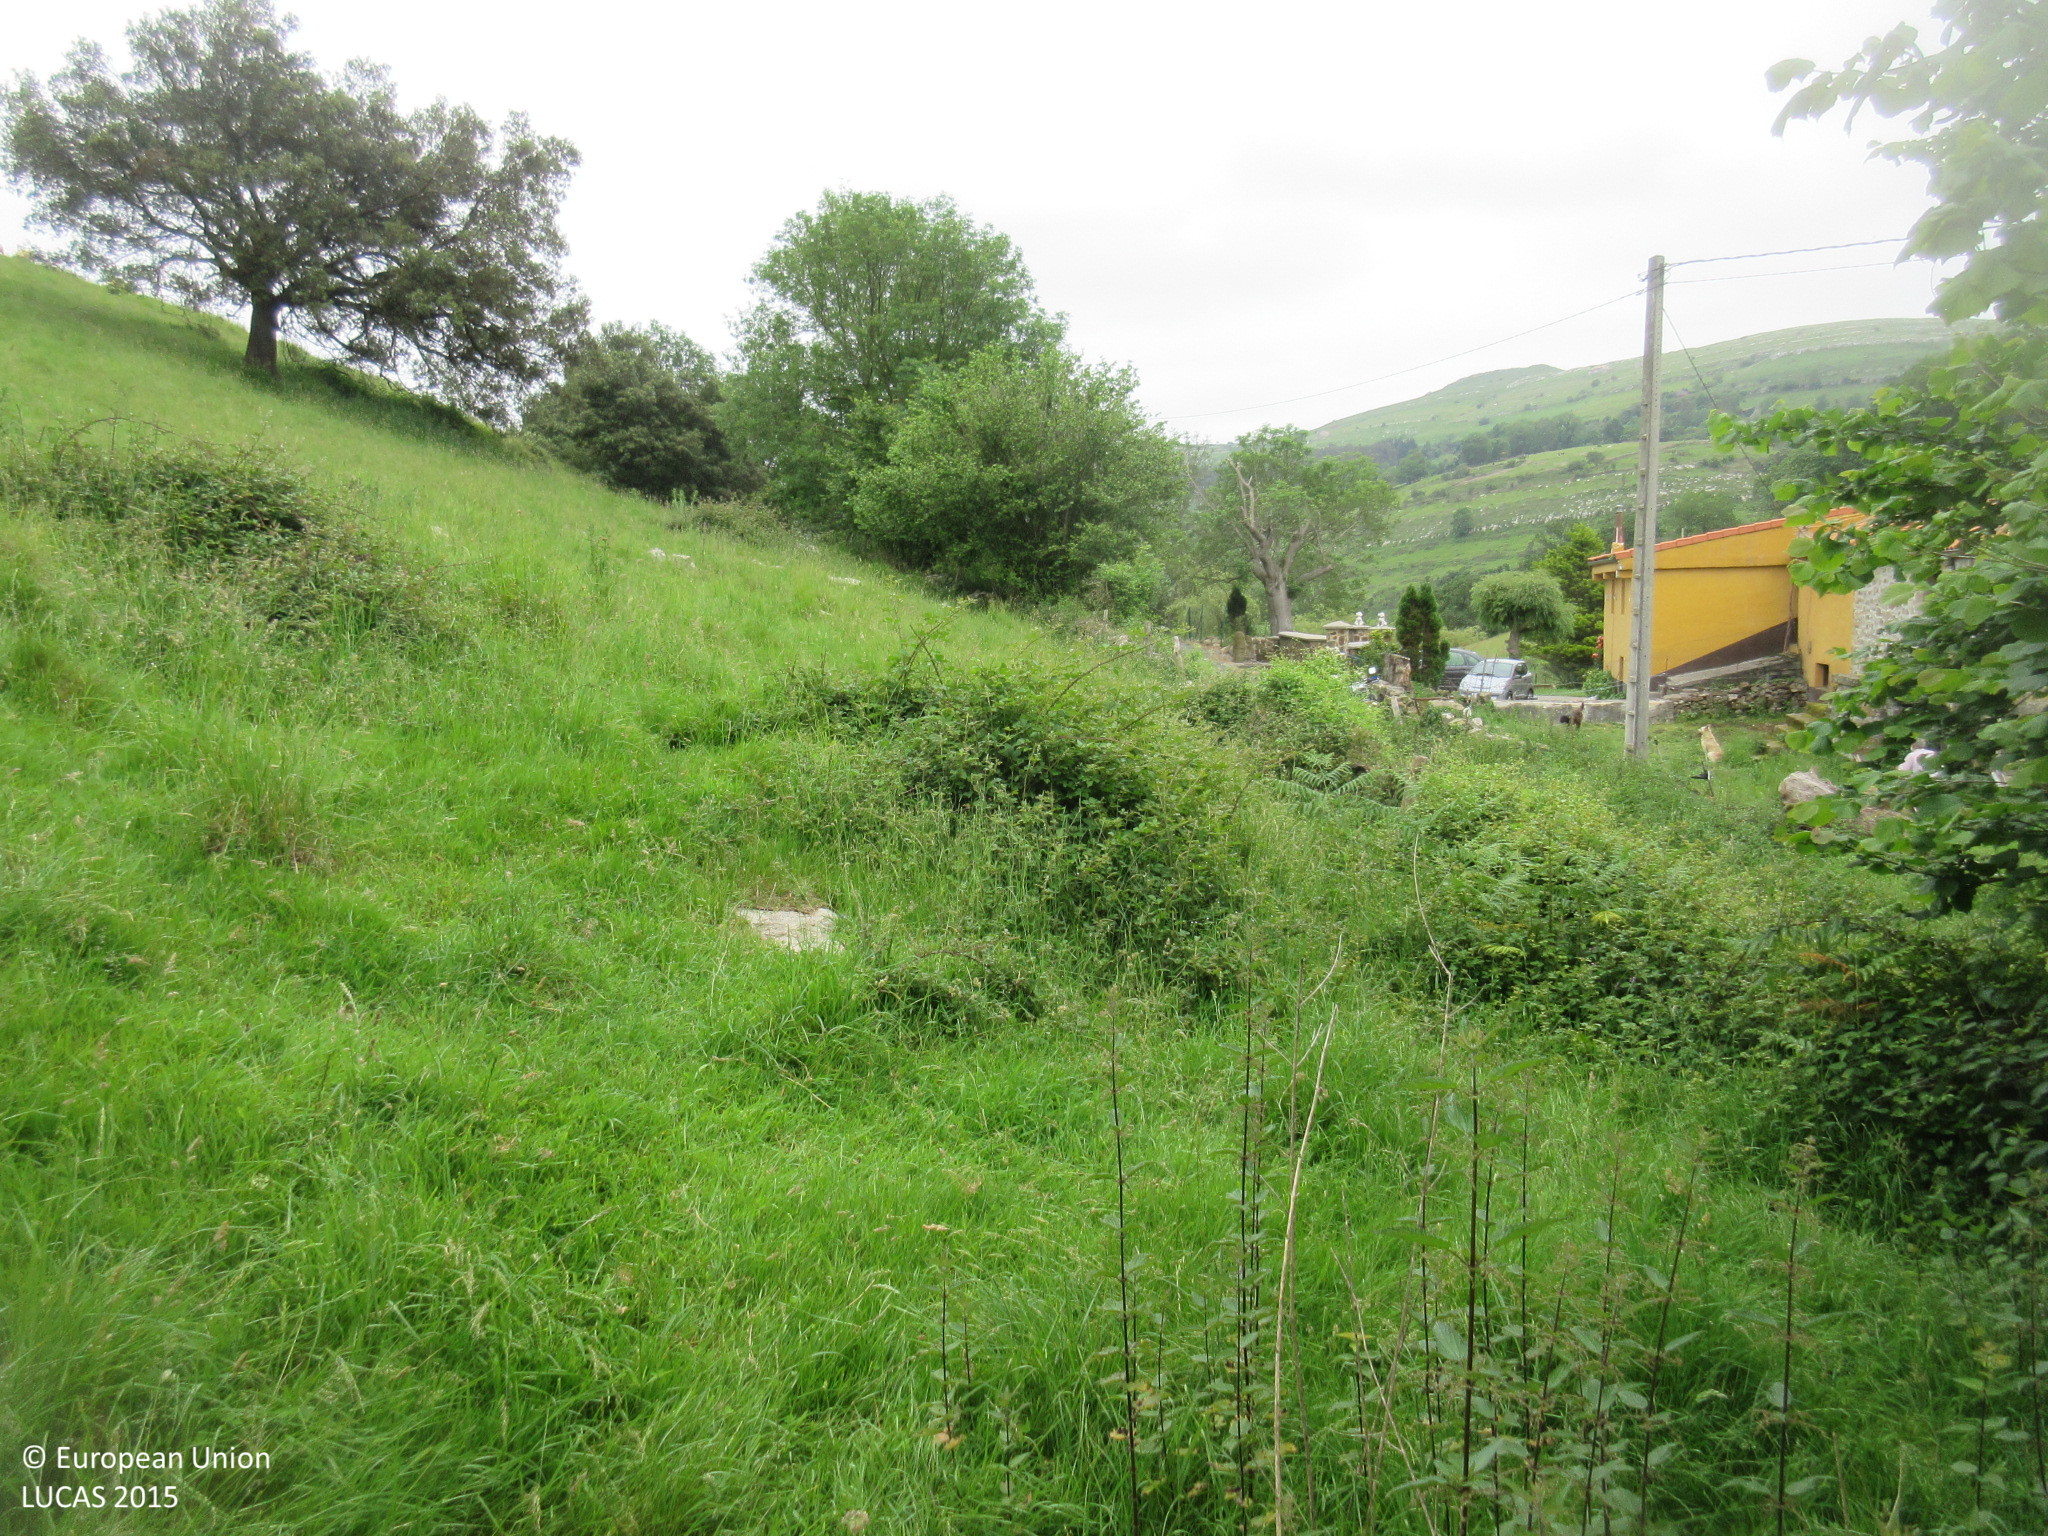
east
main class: Grassland
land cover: Grassland without tree/shrub cover
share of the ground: > 75 %
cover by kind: herbaceous plants 100 %
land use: Agriculture (excluding fallow land and kitchen gardens)
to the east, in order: Grassland without tree/shrub cover; Dry stone walls; Shruby margins; Tracks; Dry stone walls; Electric lines; Grassland without tree/shrub cover; Artificial constructions in urban areas; Grassland with sparse tree/shrub cover; Fences; Grassland without tree/shrub cover; Tracks; Grassland without tree/shrub cover; Dry stone walls; Fences; Grassland without tree/shrub cover; Tracks; Grassland without tree/shrub cover; Broadleaved woodland
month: June
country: ES
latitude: 43.3374
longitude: -3.6253
